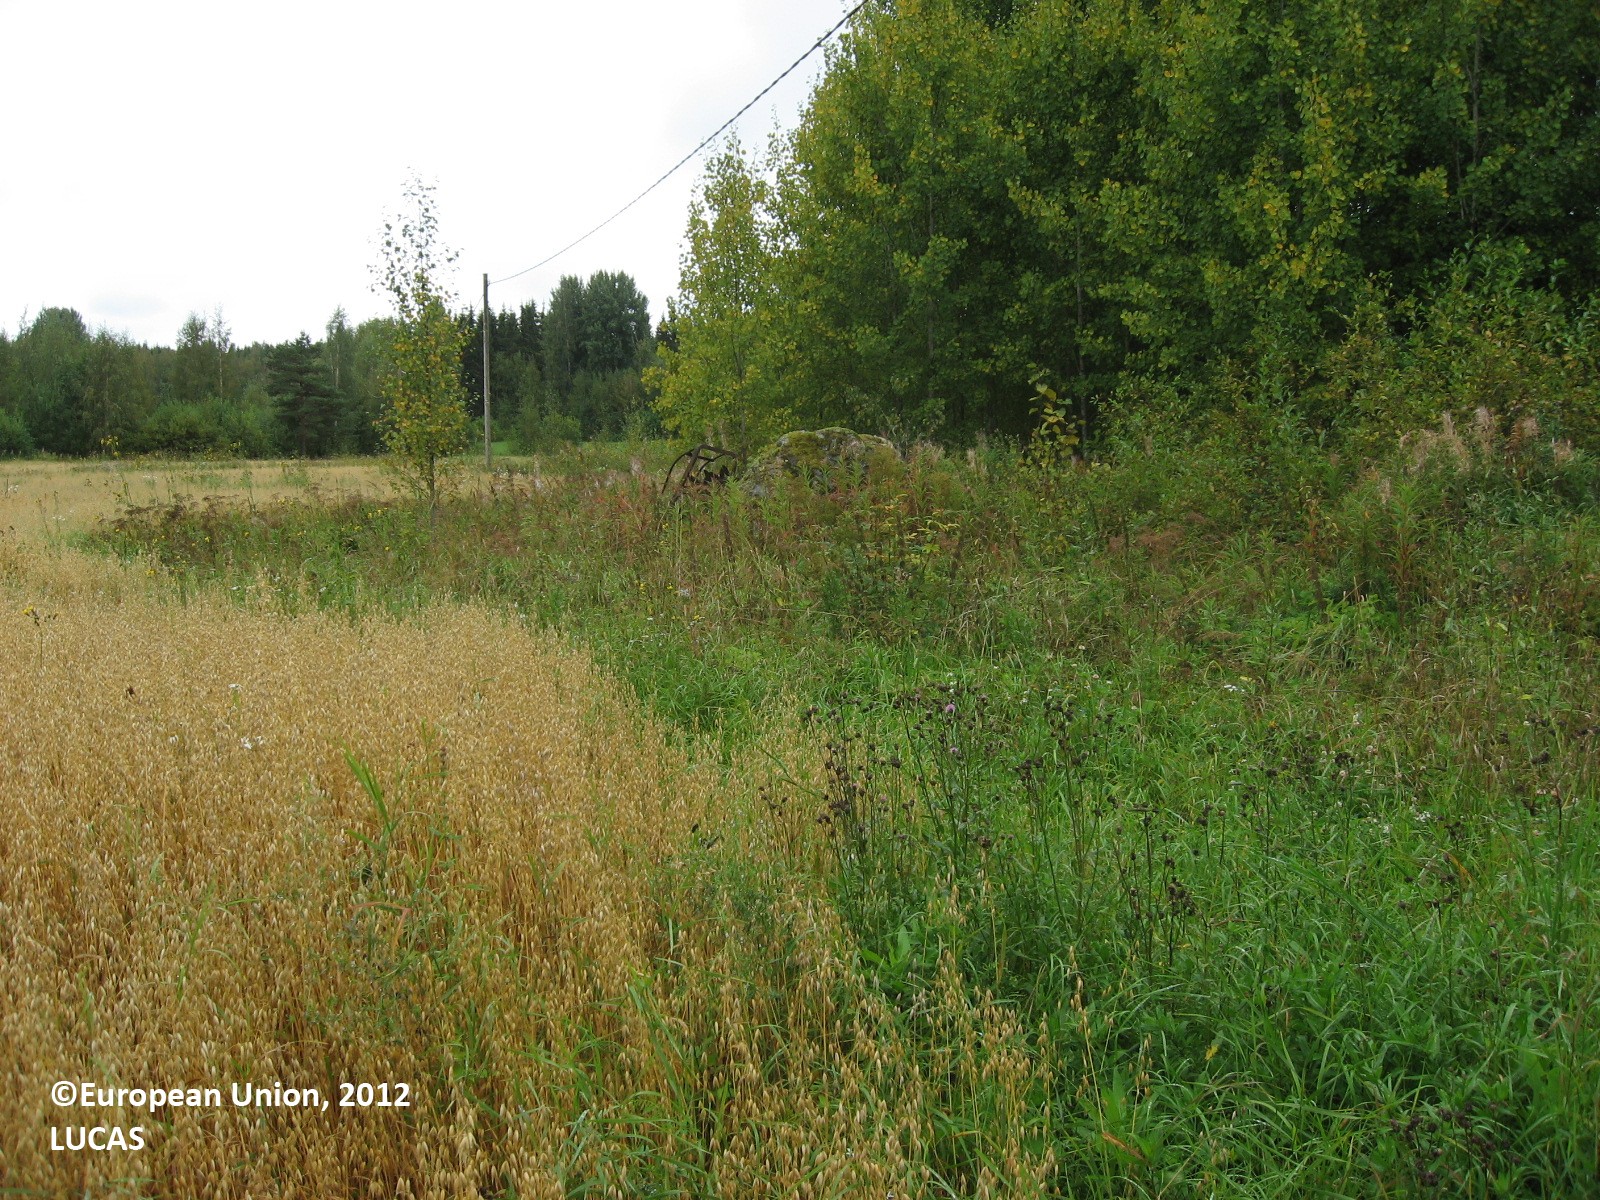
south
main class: Cropland
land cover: Oats
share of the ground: > 75 %
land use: Agriculture (excluding fallow land and kitchen gardens)
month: August
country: FI
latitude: 61.4351
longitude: 24.7846
